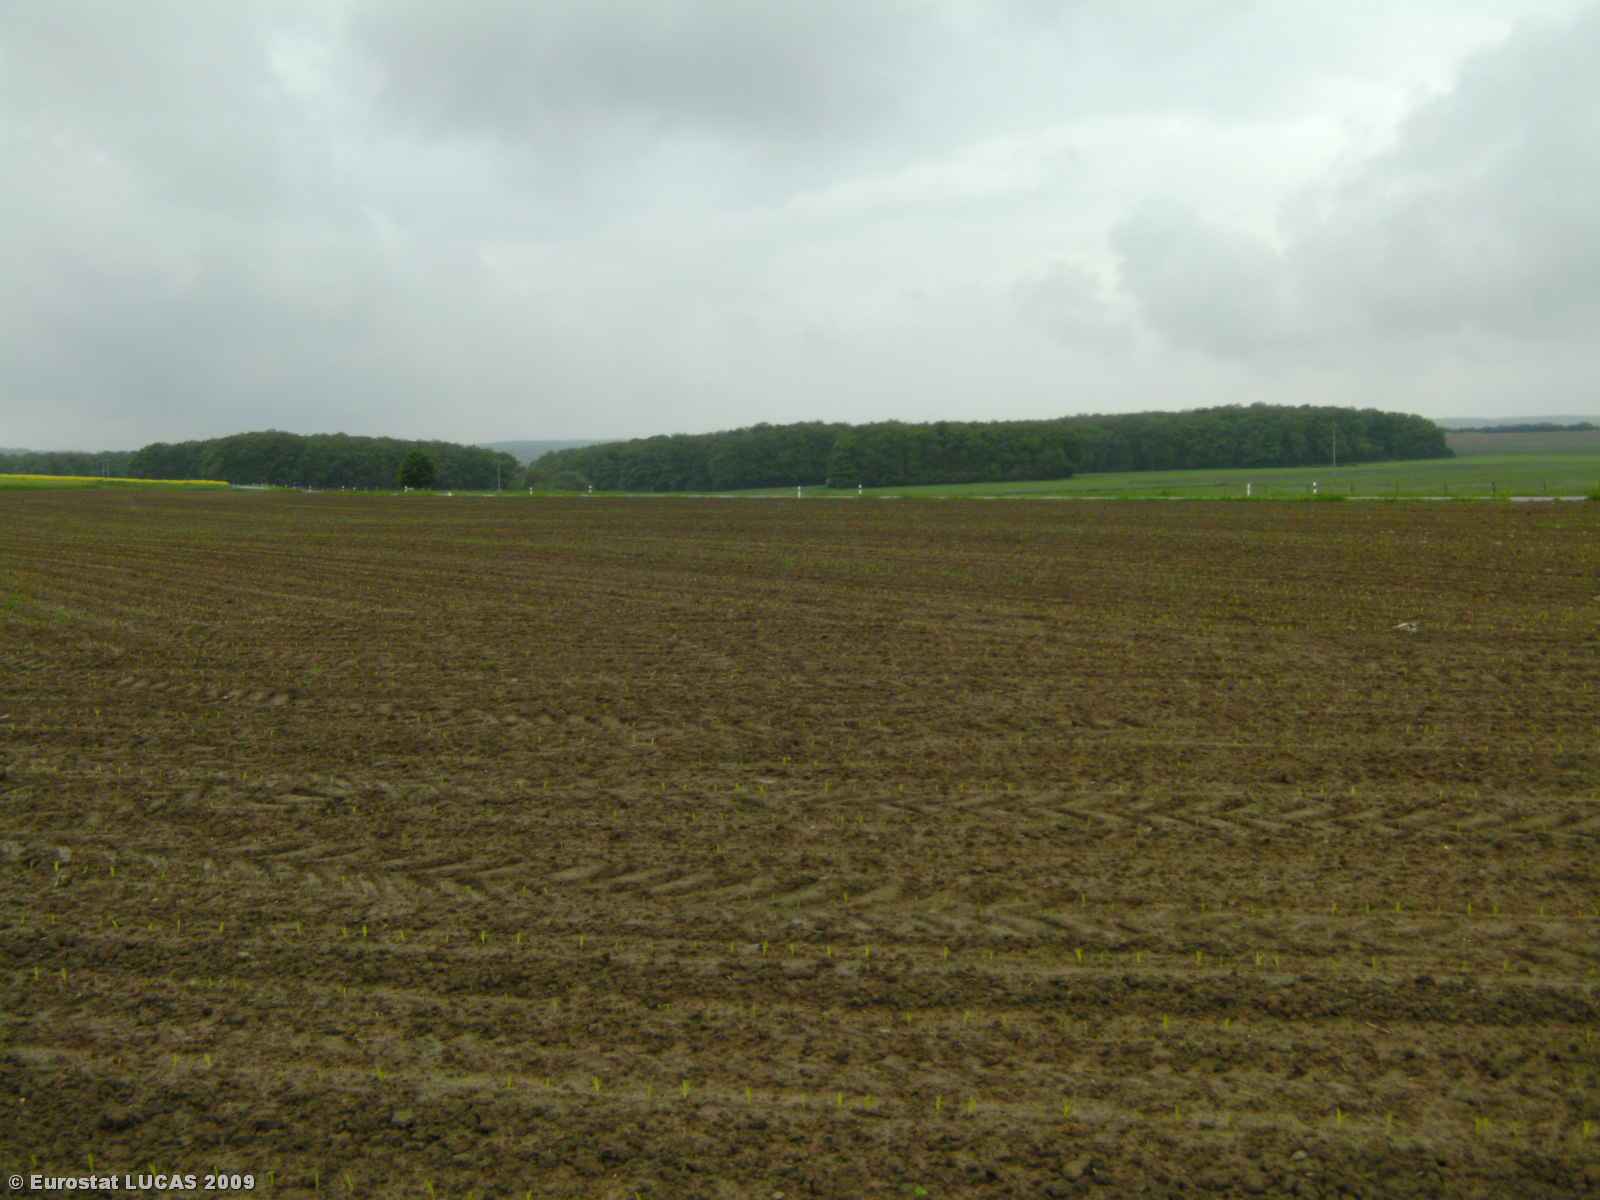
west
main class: Cropland
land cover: Maize
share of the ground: < 10 %
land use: Agriculture (excluding fallow land and kitchen gardens)
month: May
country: LU
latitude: 49.7810
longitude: 6.2637
